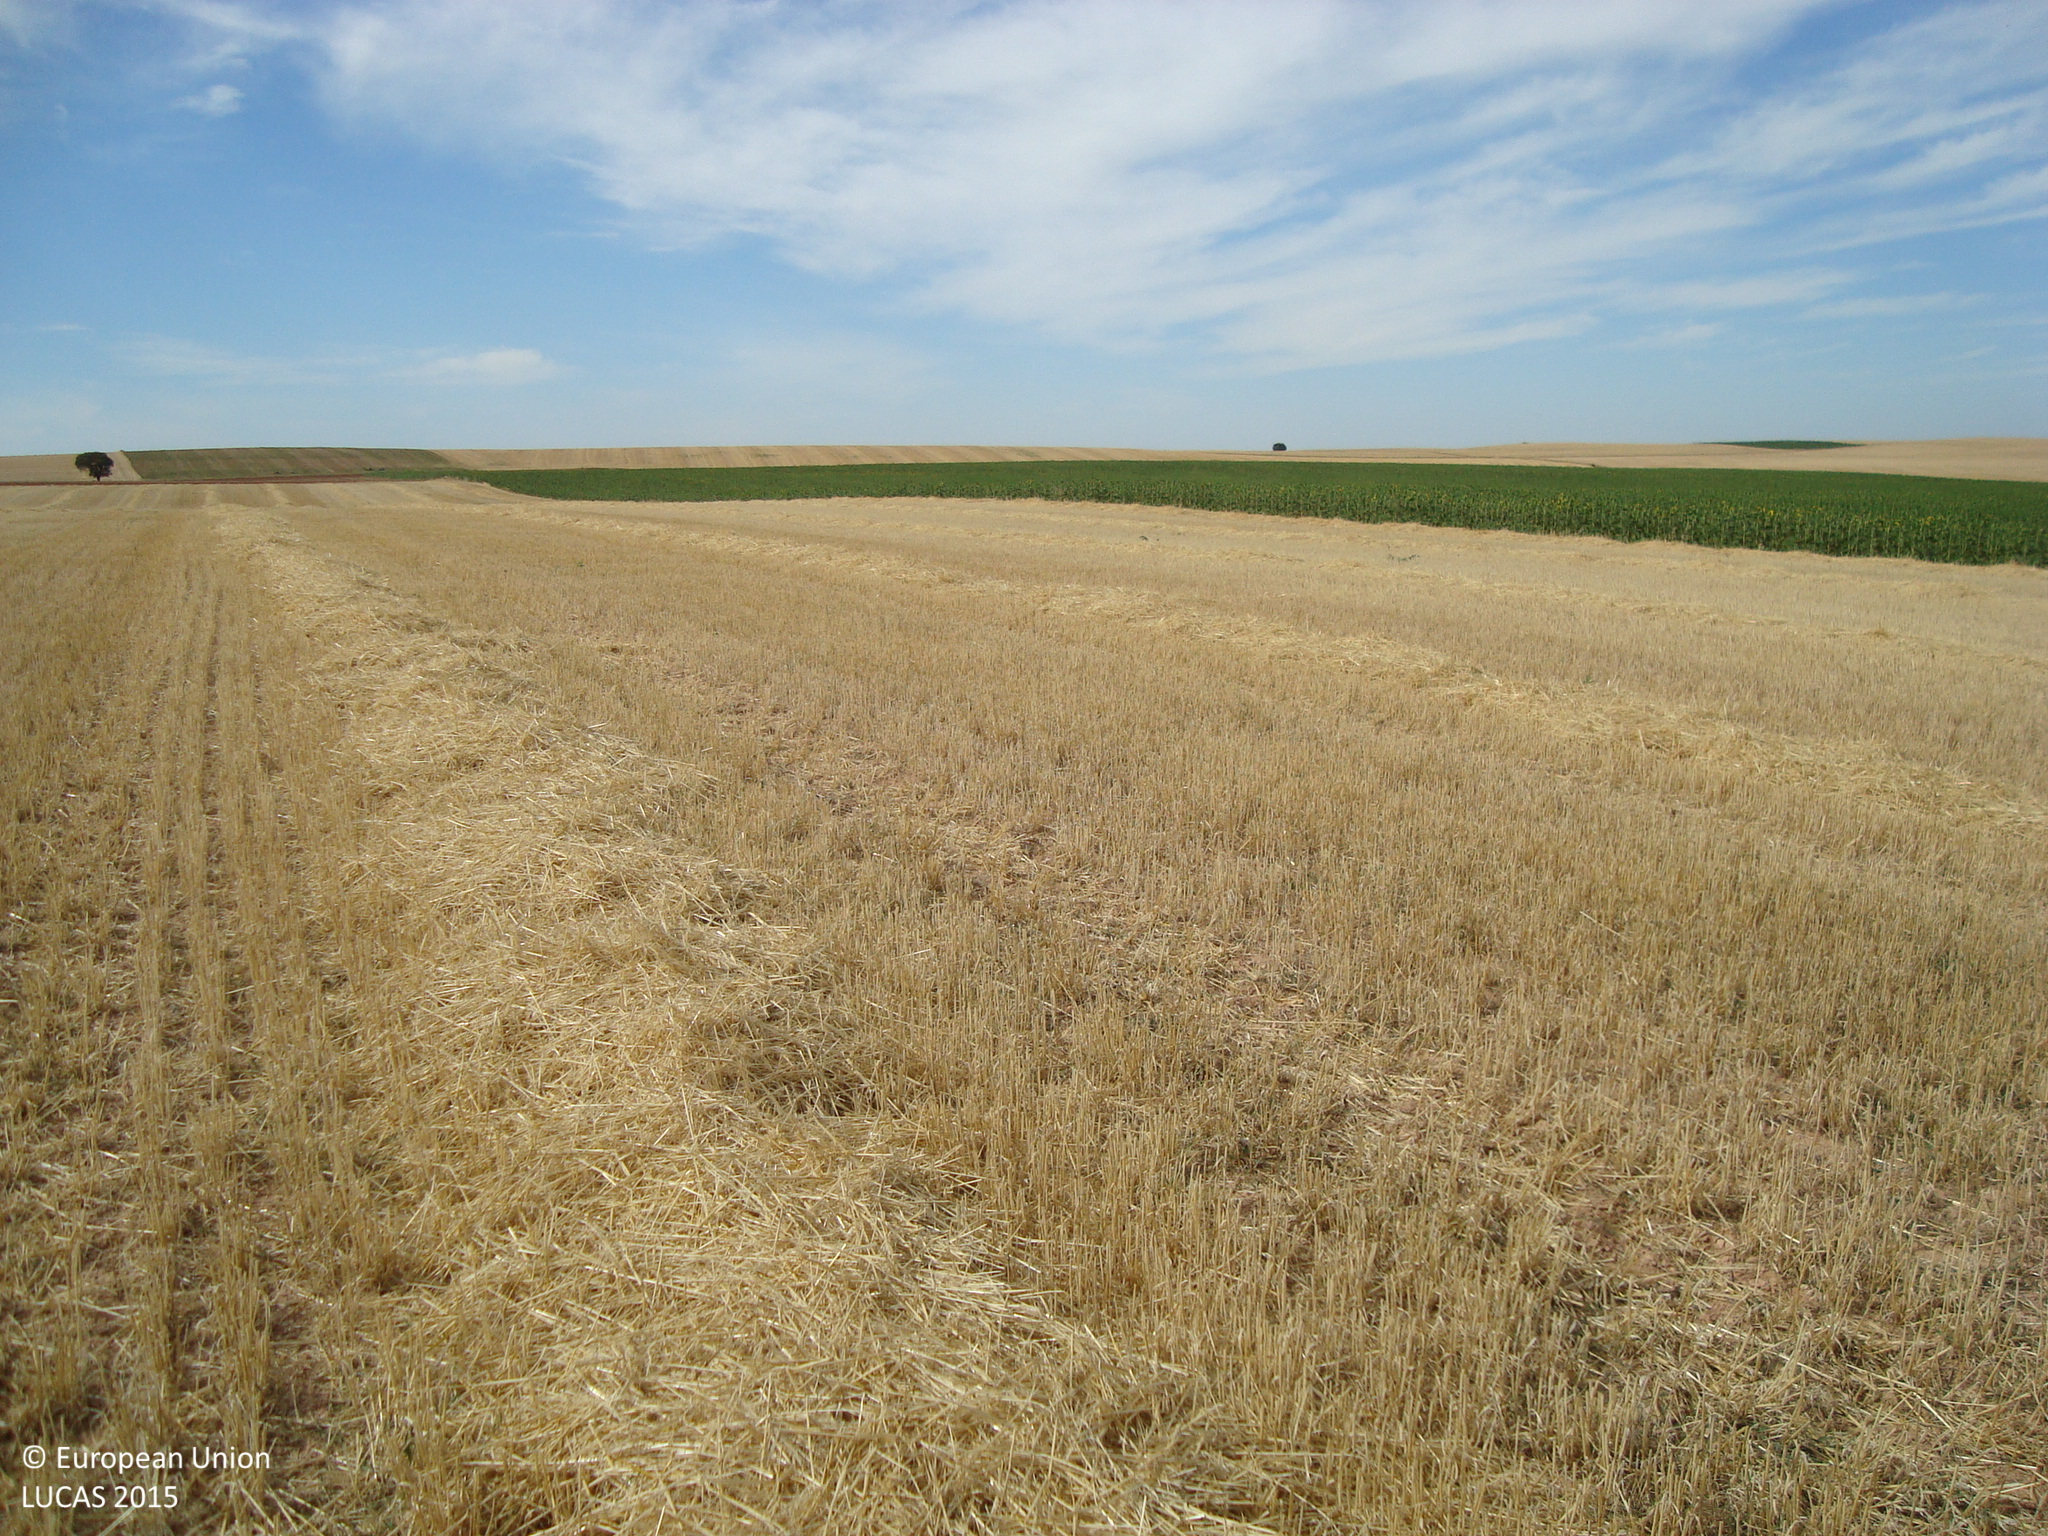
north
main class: Cropland
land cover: Barley
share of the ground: > 75 %
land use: Agriculture (excluding fallow land and kitchen gardens)
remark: Harvested field
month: July
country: ES
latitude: 42.1344
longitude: -3.8649
